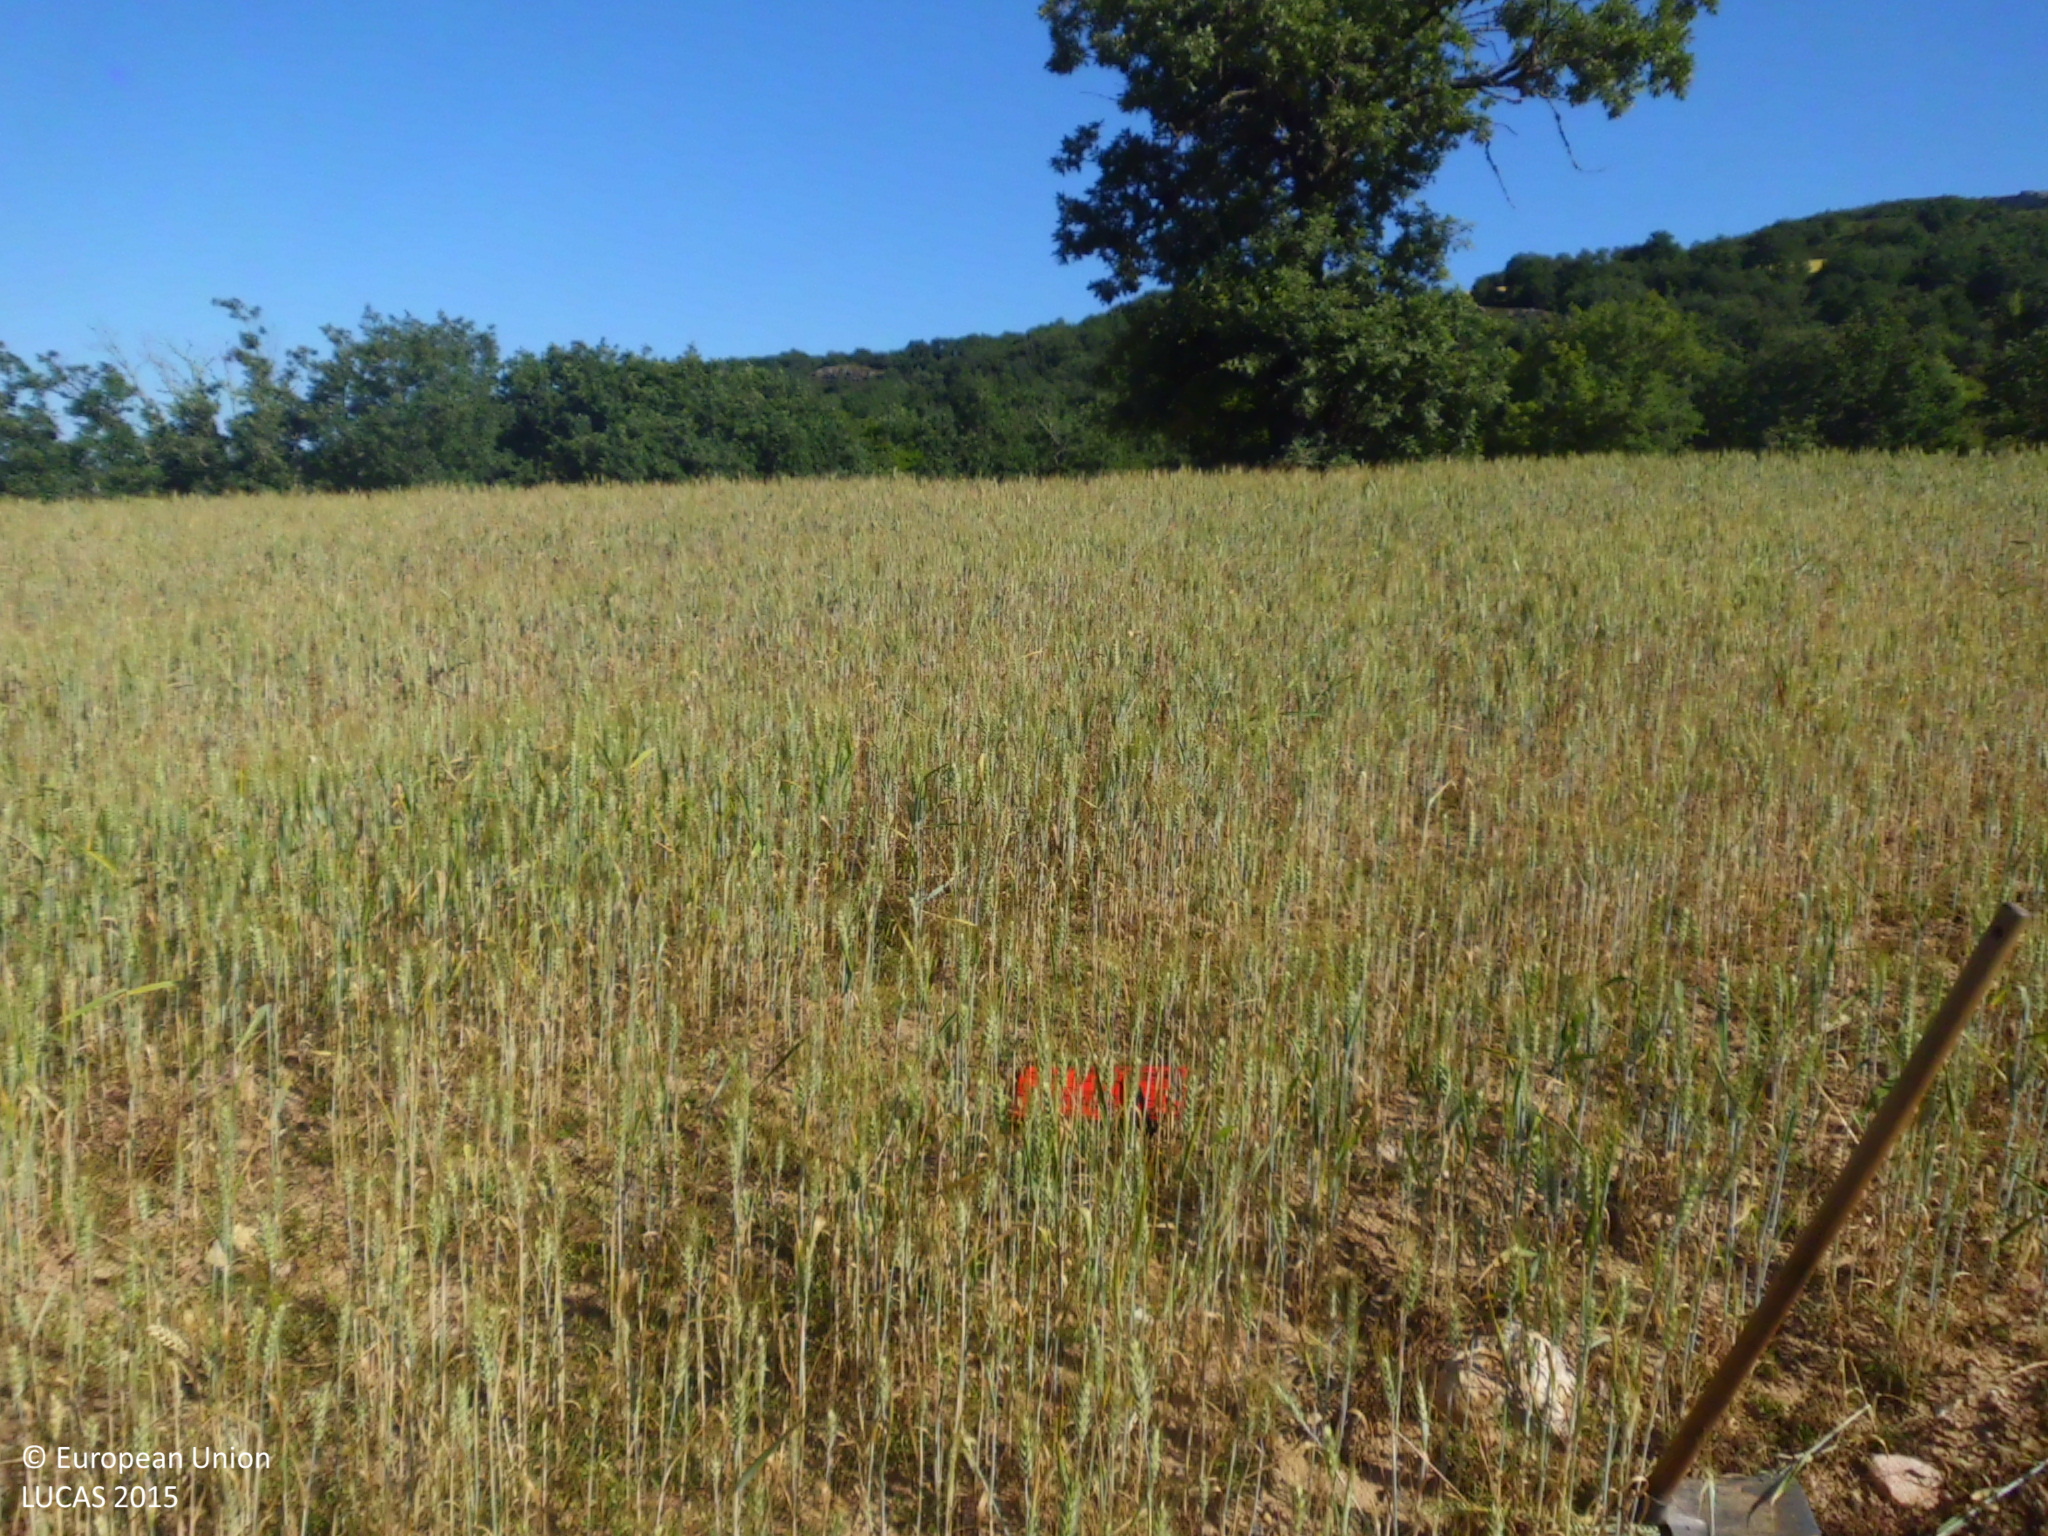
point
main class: Cropland
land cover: Common wheat
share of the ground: 25 - 50 %
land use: Agriculture (excluding fallow land and kitchen gardens)
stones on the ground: 10 - 25 %
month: June
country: ES
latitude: 42.6591
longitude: -4.0378
